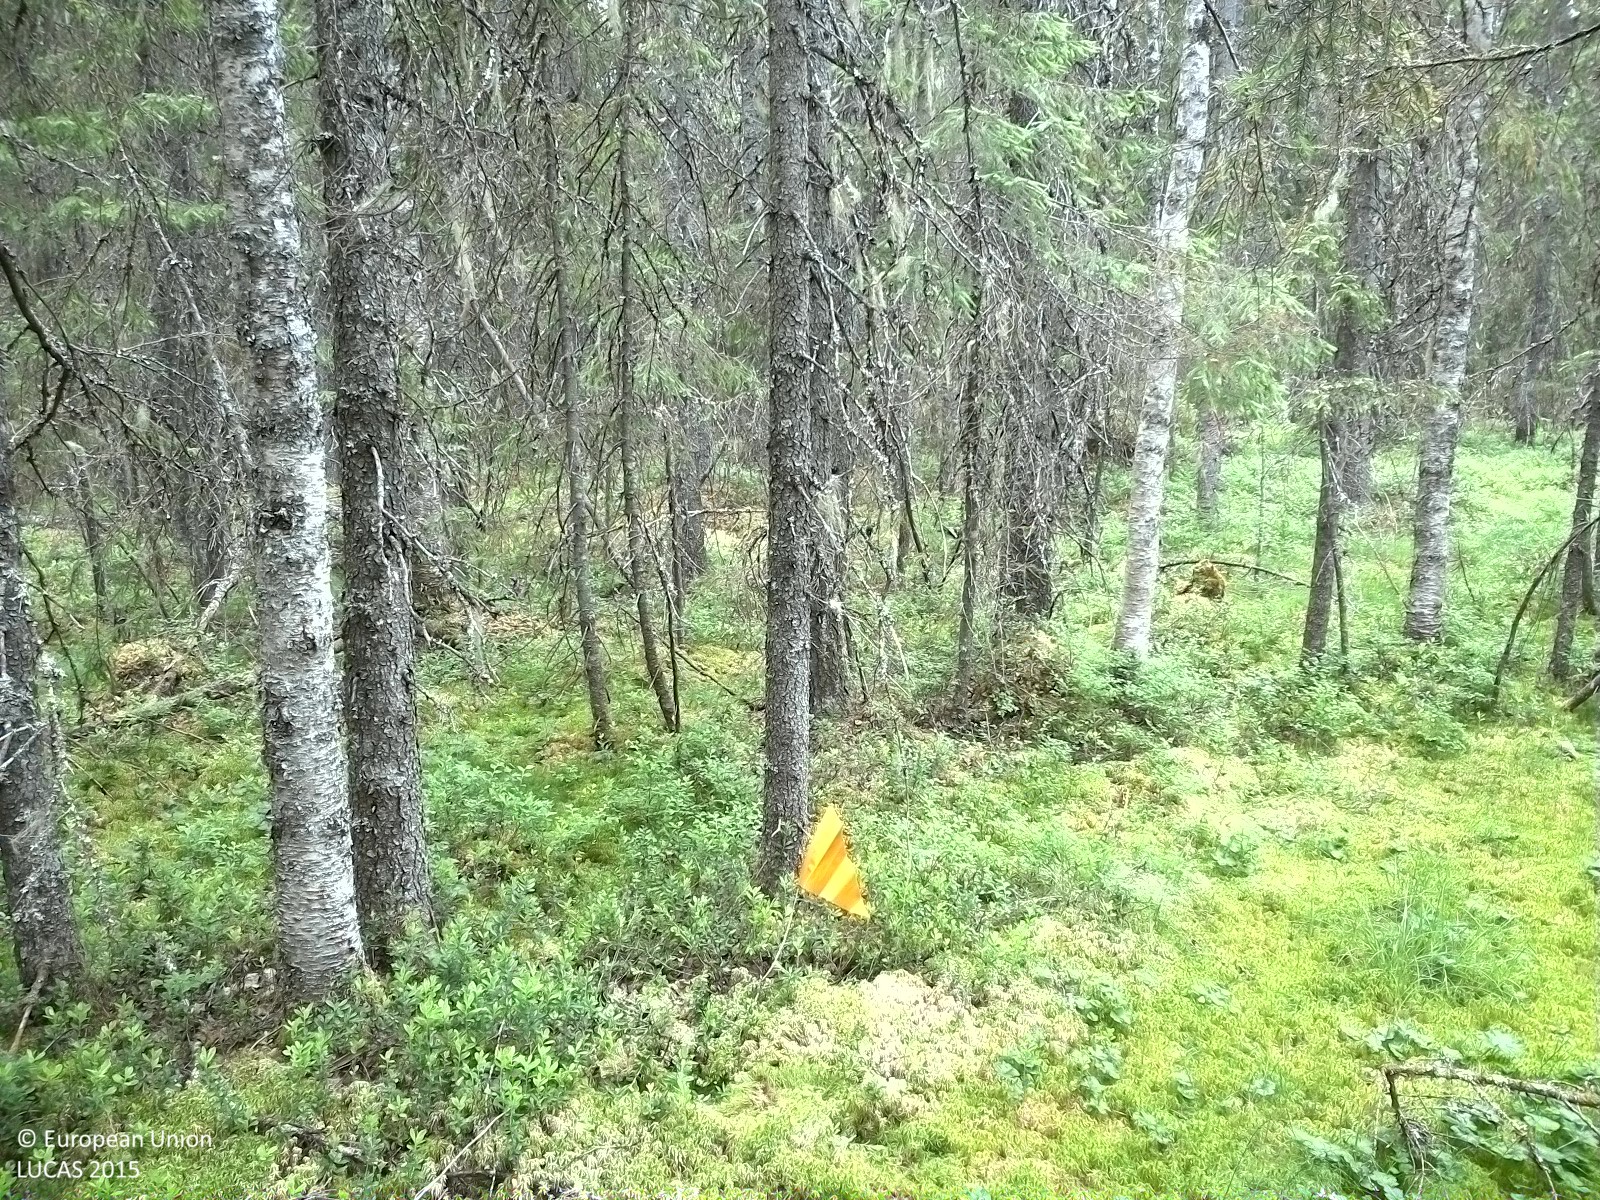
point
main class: Woodland
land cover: Spruce dominated coniferous woodland
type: boreal forest
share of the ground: 25 - 50 %
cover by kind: coniferous forest trees 45 %, lichens and mosses 30 %, shrubs 20 %, broadleaved forest trees 5 %
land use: Forestry
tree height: > 5 m
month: July
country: SE
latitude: 62.1084
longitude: 16.9373
